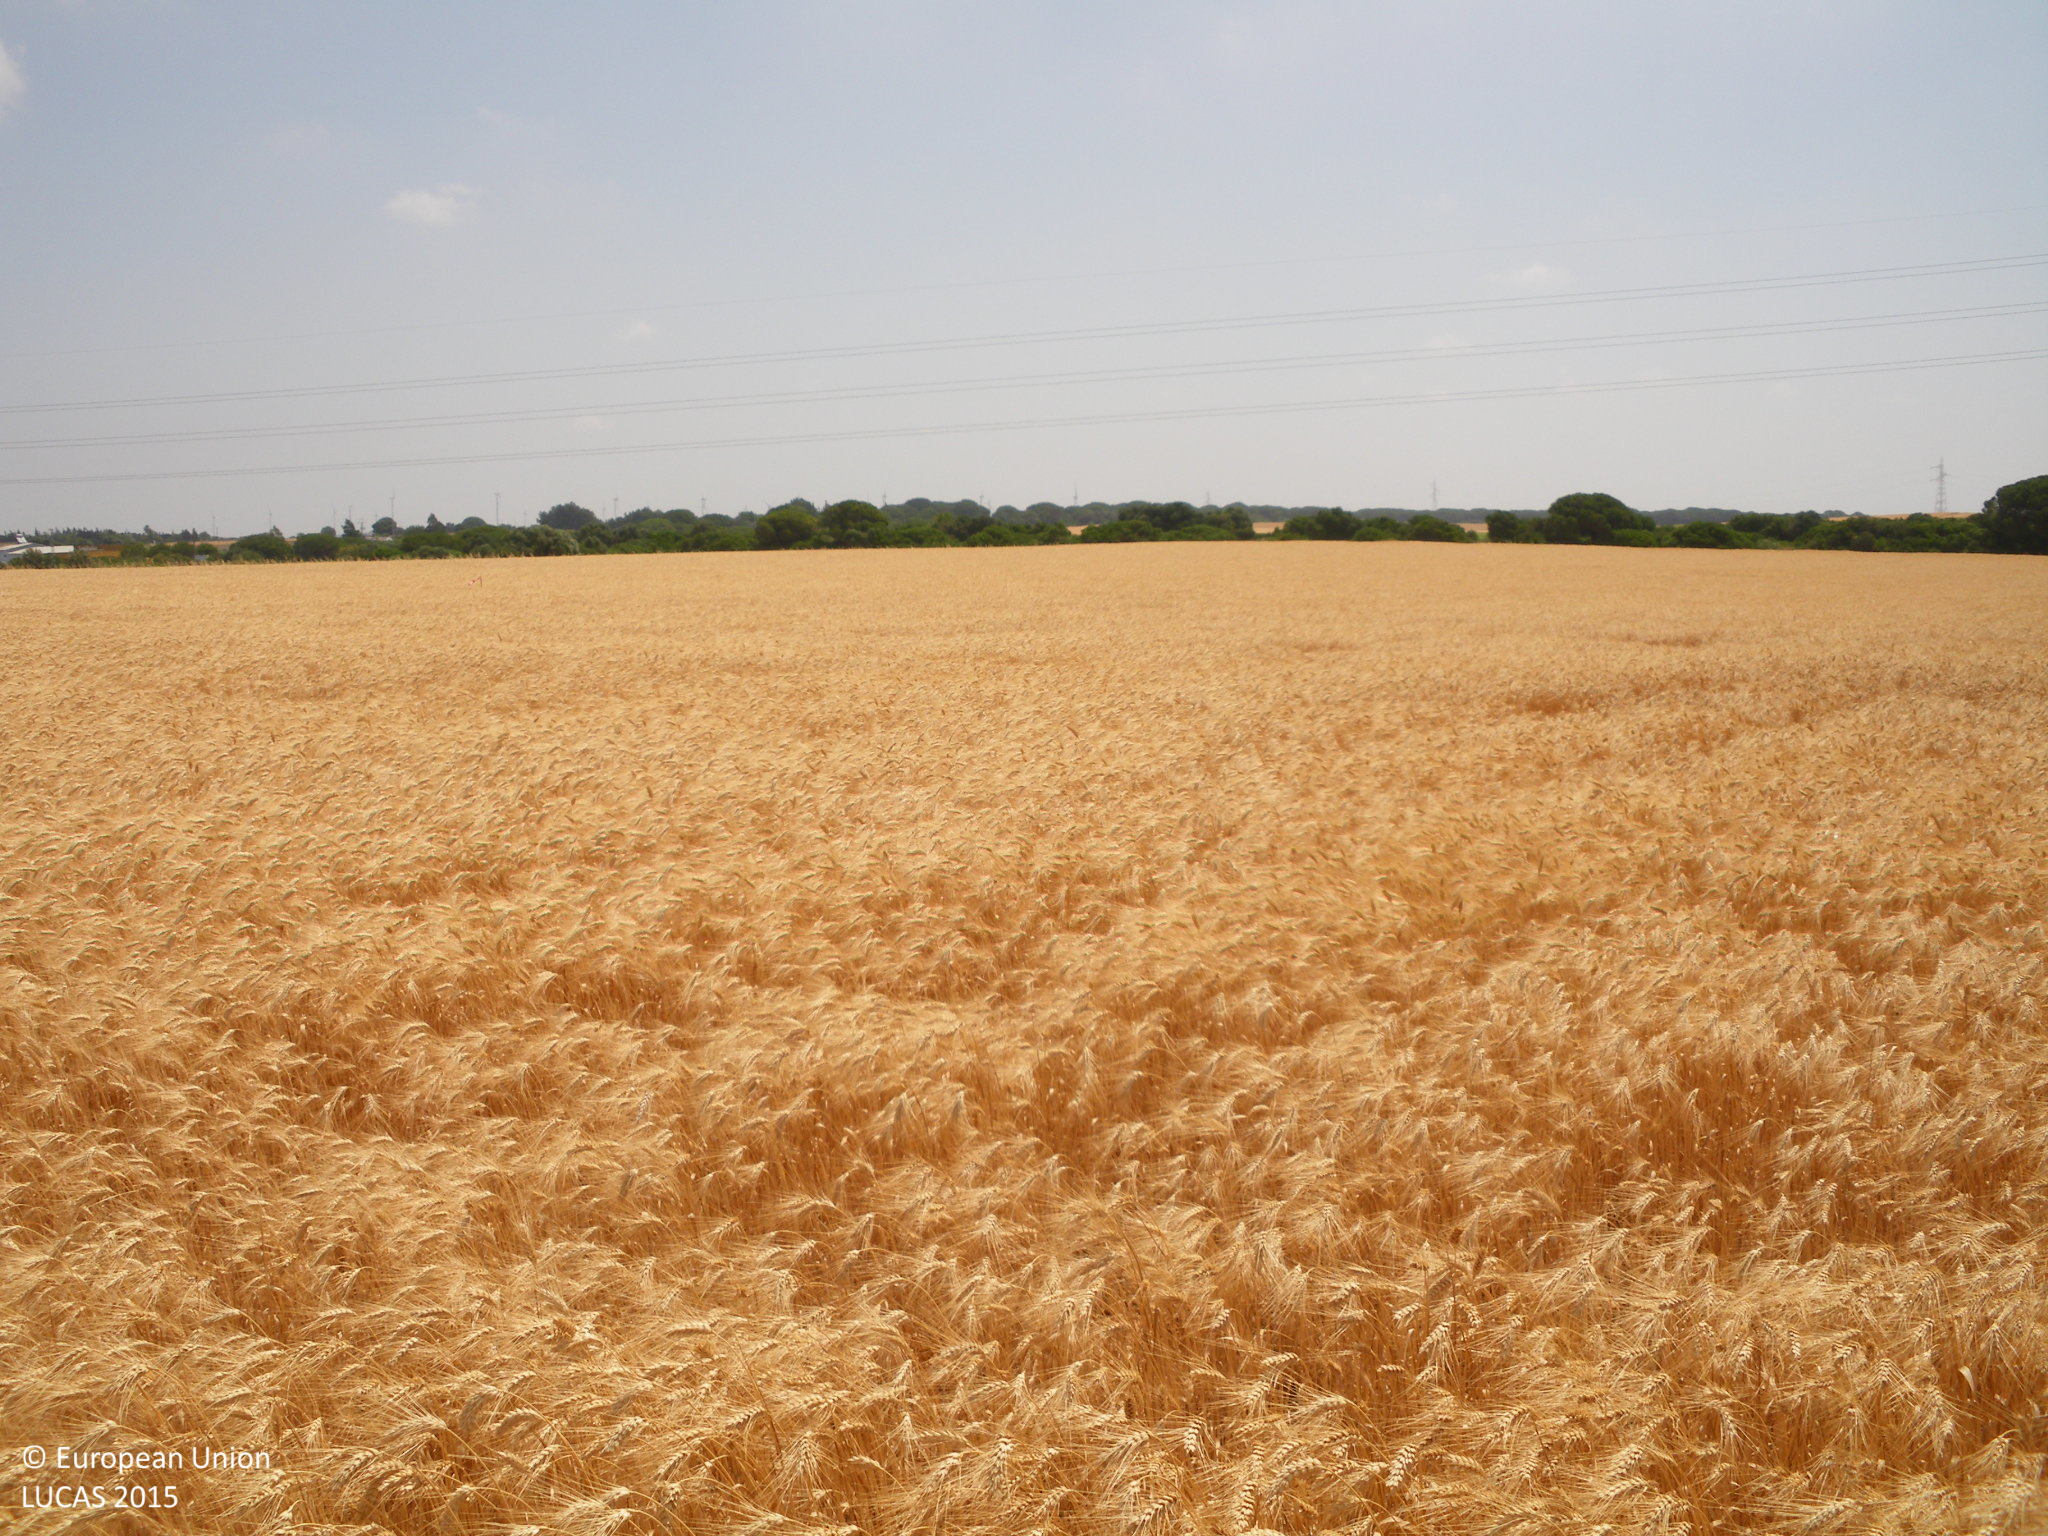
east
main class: Cropland
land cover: Durum wheat
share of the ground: > 75 %
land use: Agriculture (excluding fallow land and kitchen gardens)
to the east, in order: Durum wheat; Electric lines; Durum wheat
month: May
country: ES
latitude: 36.5239
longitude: -6.1466
